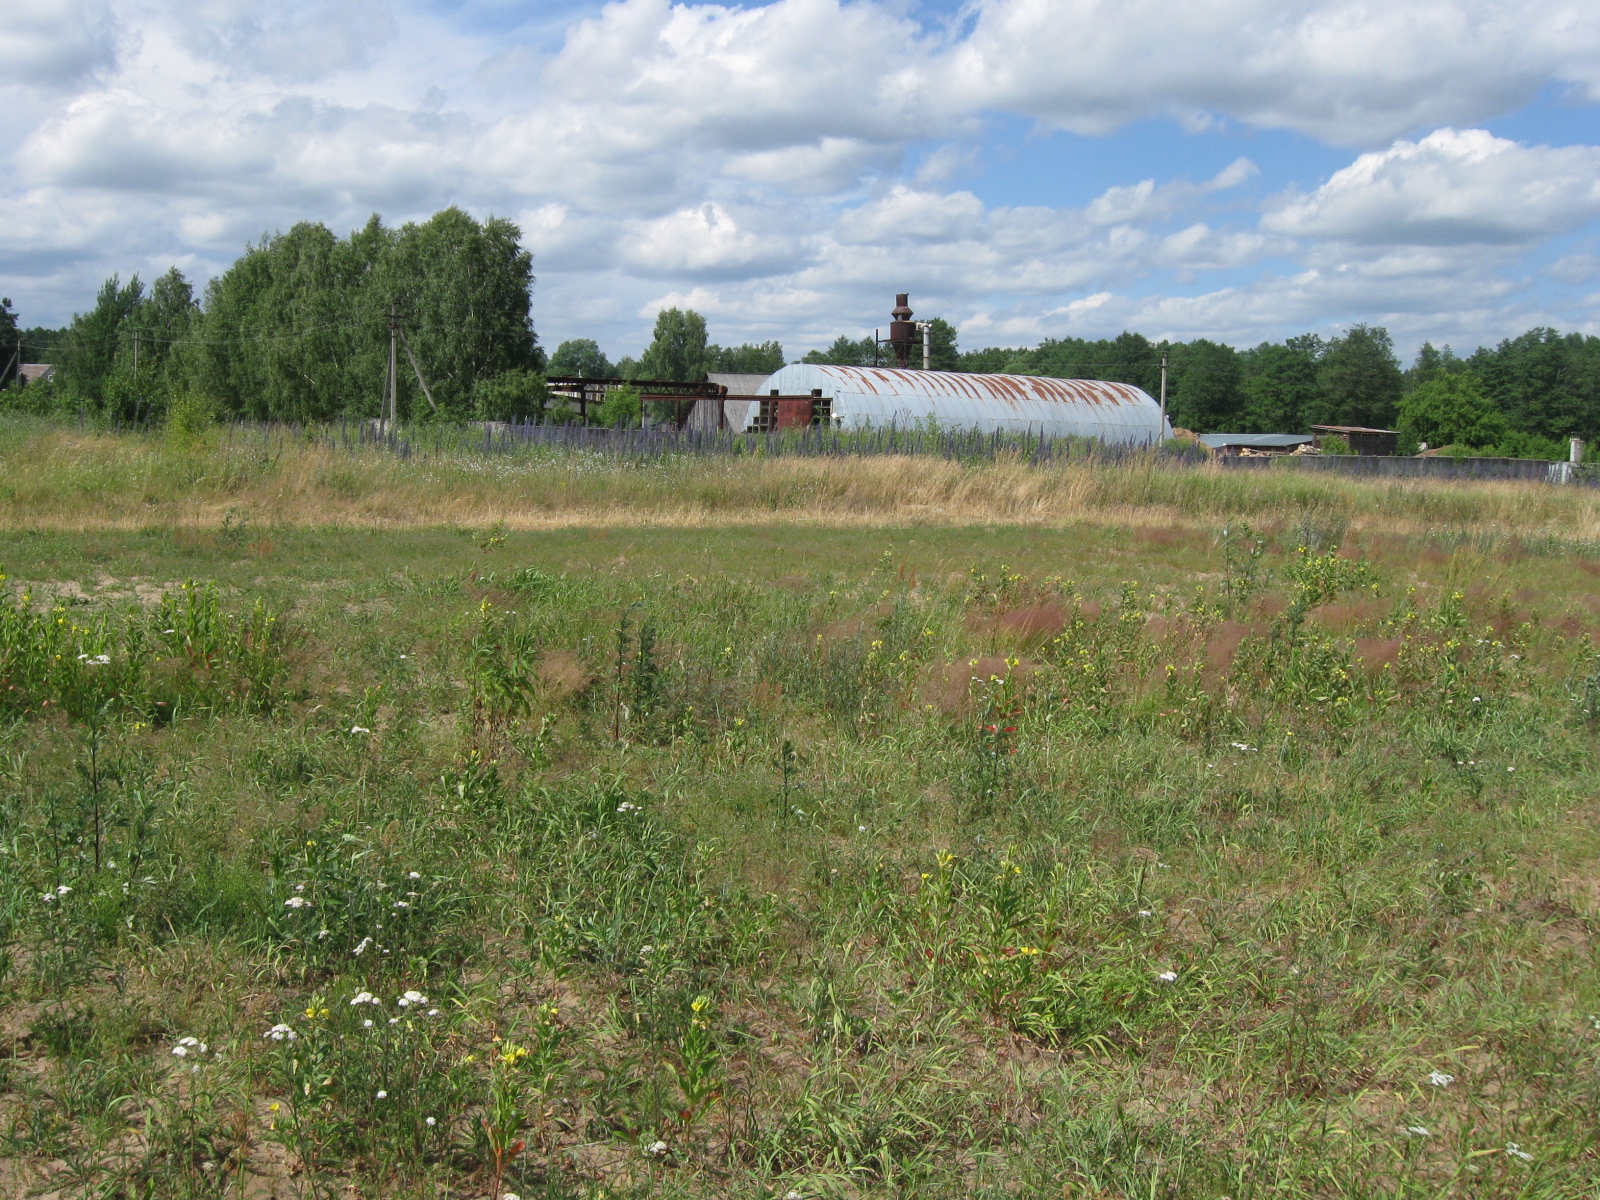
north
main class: Grassland
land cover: Spontaneously vegetated surfaces
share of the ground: > 75 %
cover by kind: herbaceous plants 75 %, unconsolidated bare surface 25 %
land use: Fallow land
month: June
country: LT
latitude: 54.2543
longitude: 24.5484
